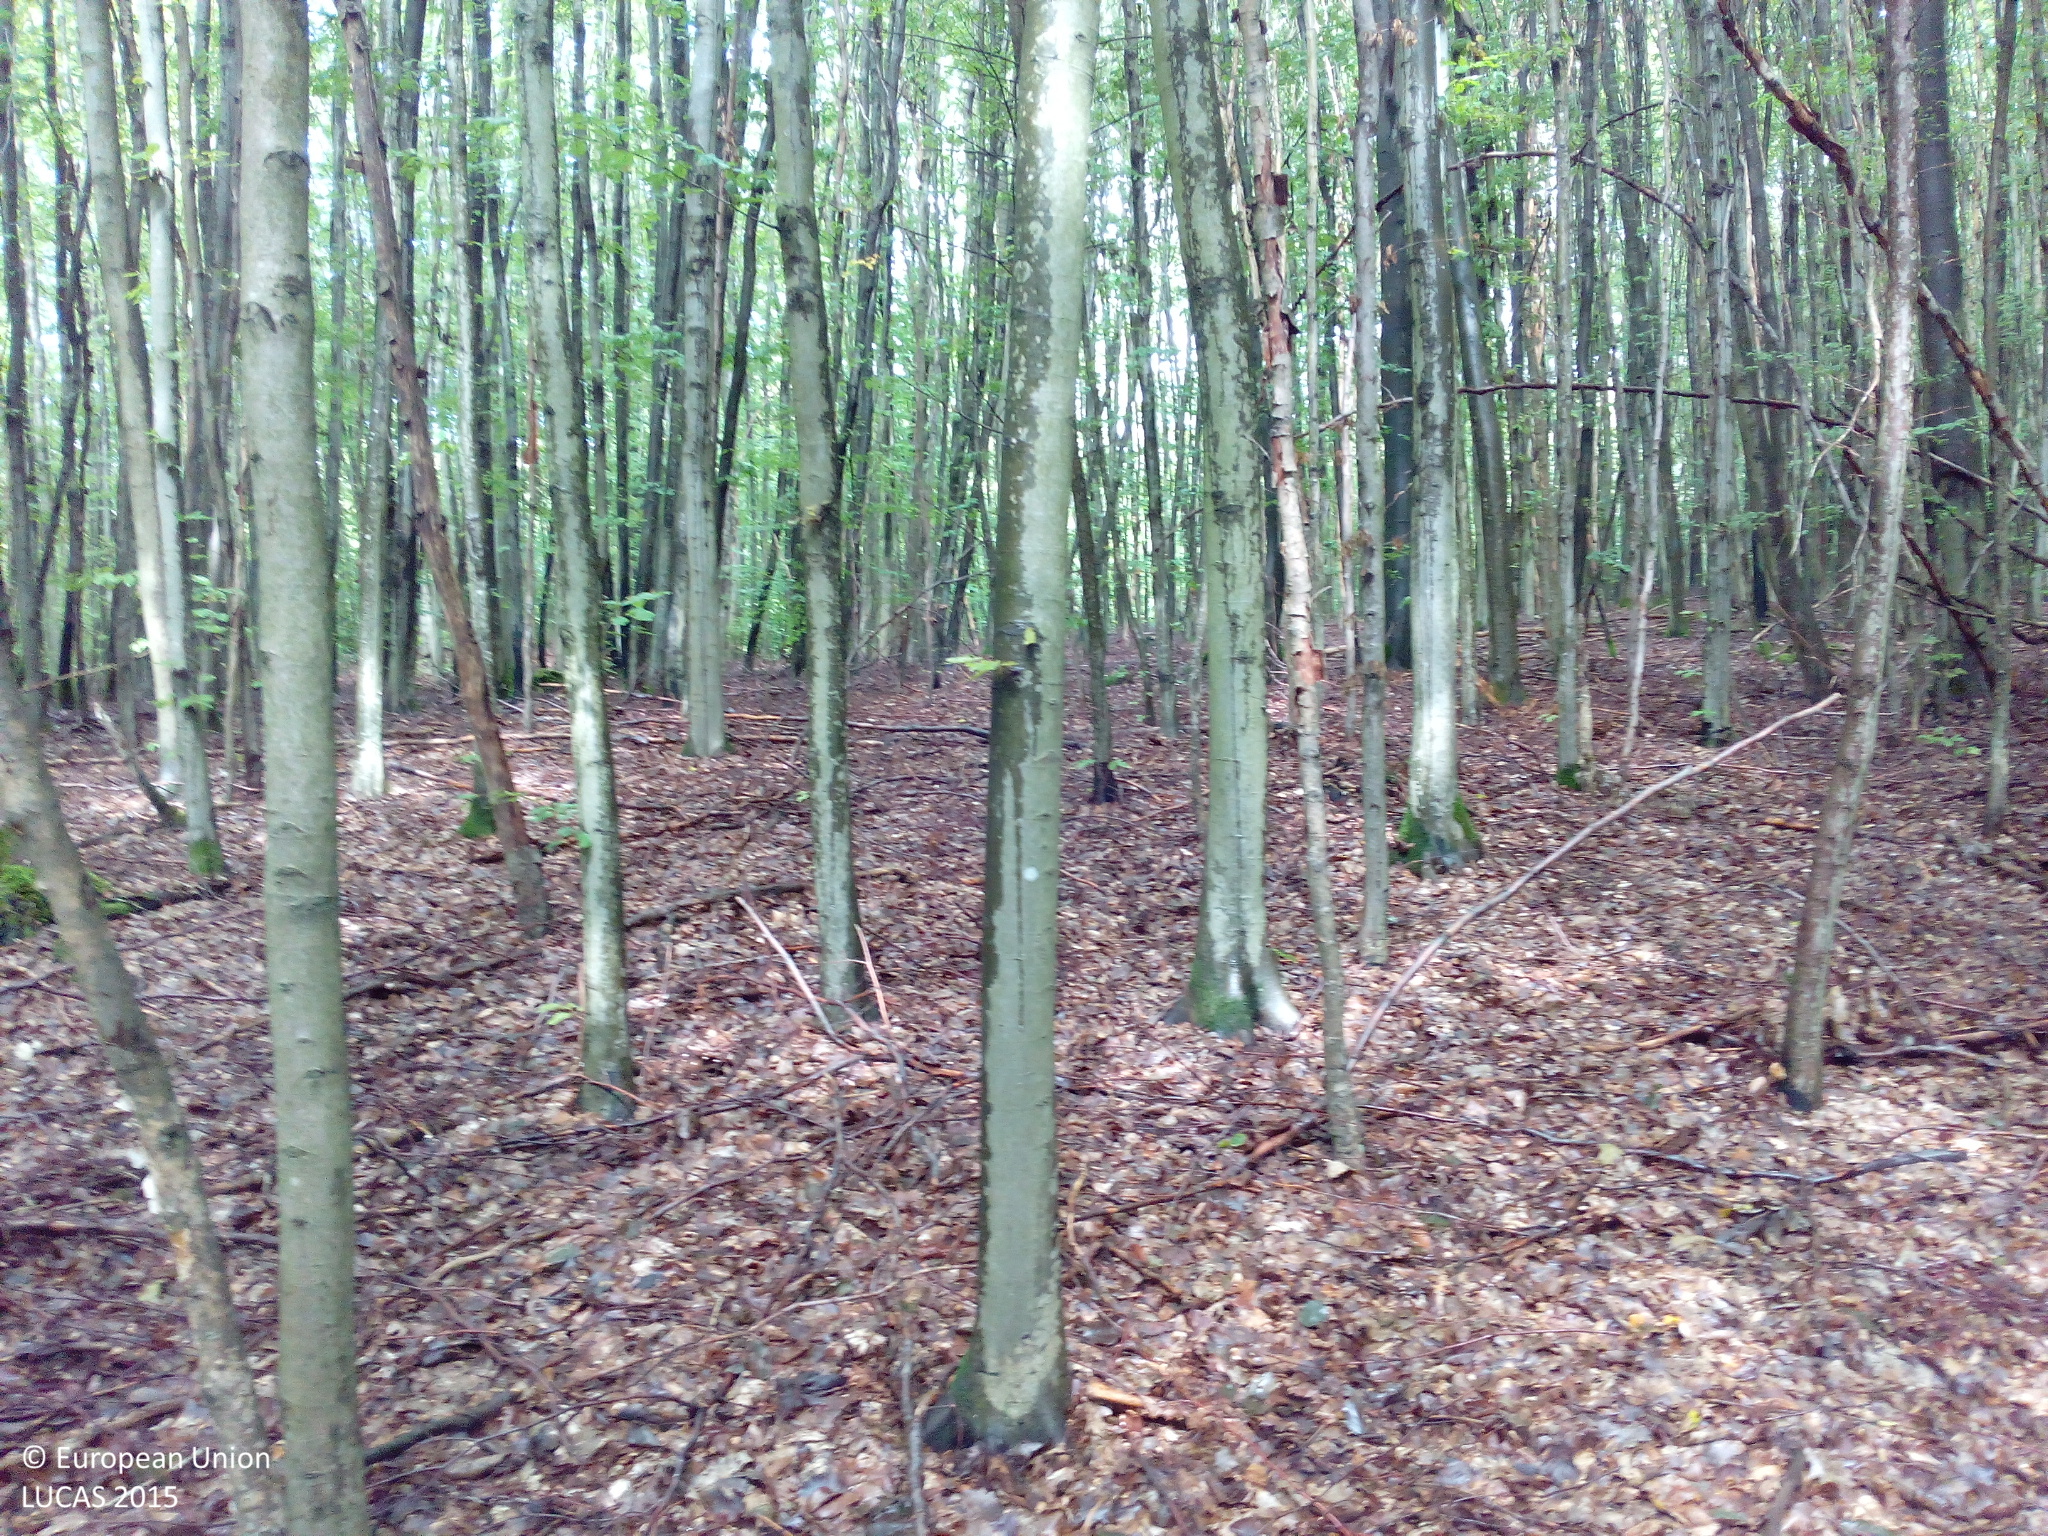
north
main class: Woodland
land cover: Broadleaved woodland
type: beech forest
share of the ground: > 75 %
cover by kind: broadleaved forest trees 100 %
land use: Forestry
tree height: > 5 m
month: September
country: DE
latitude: 50.0755
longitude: 9.5670
